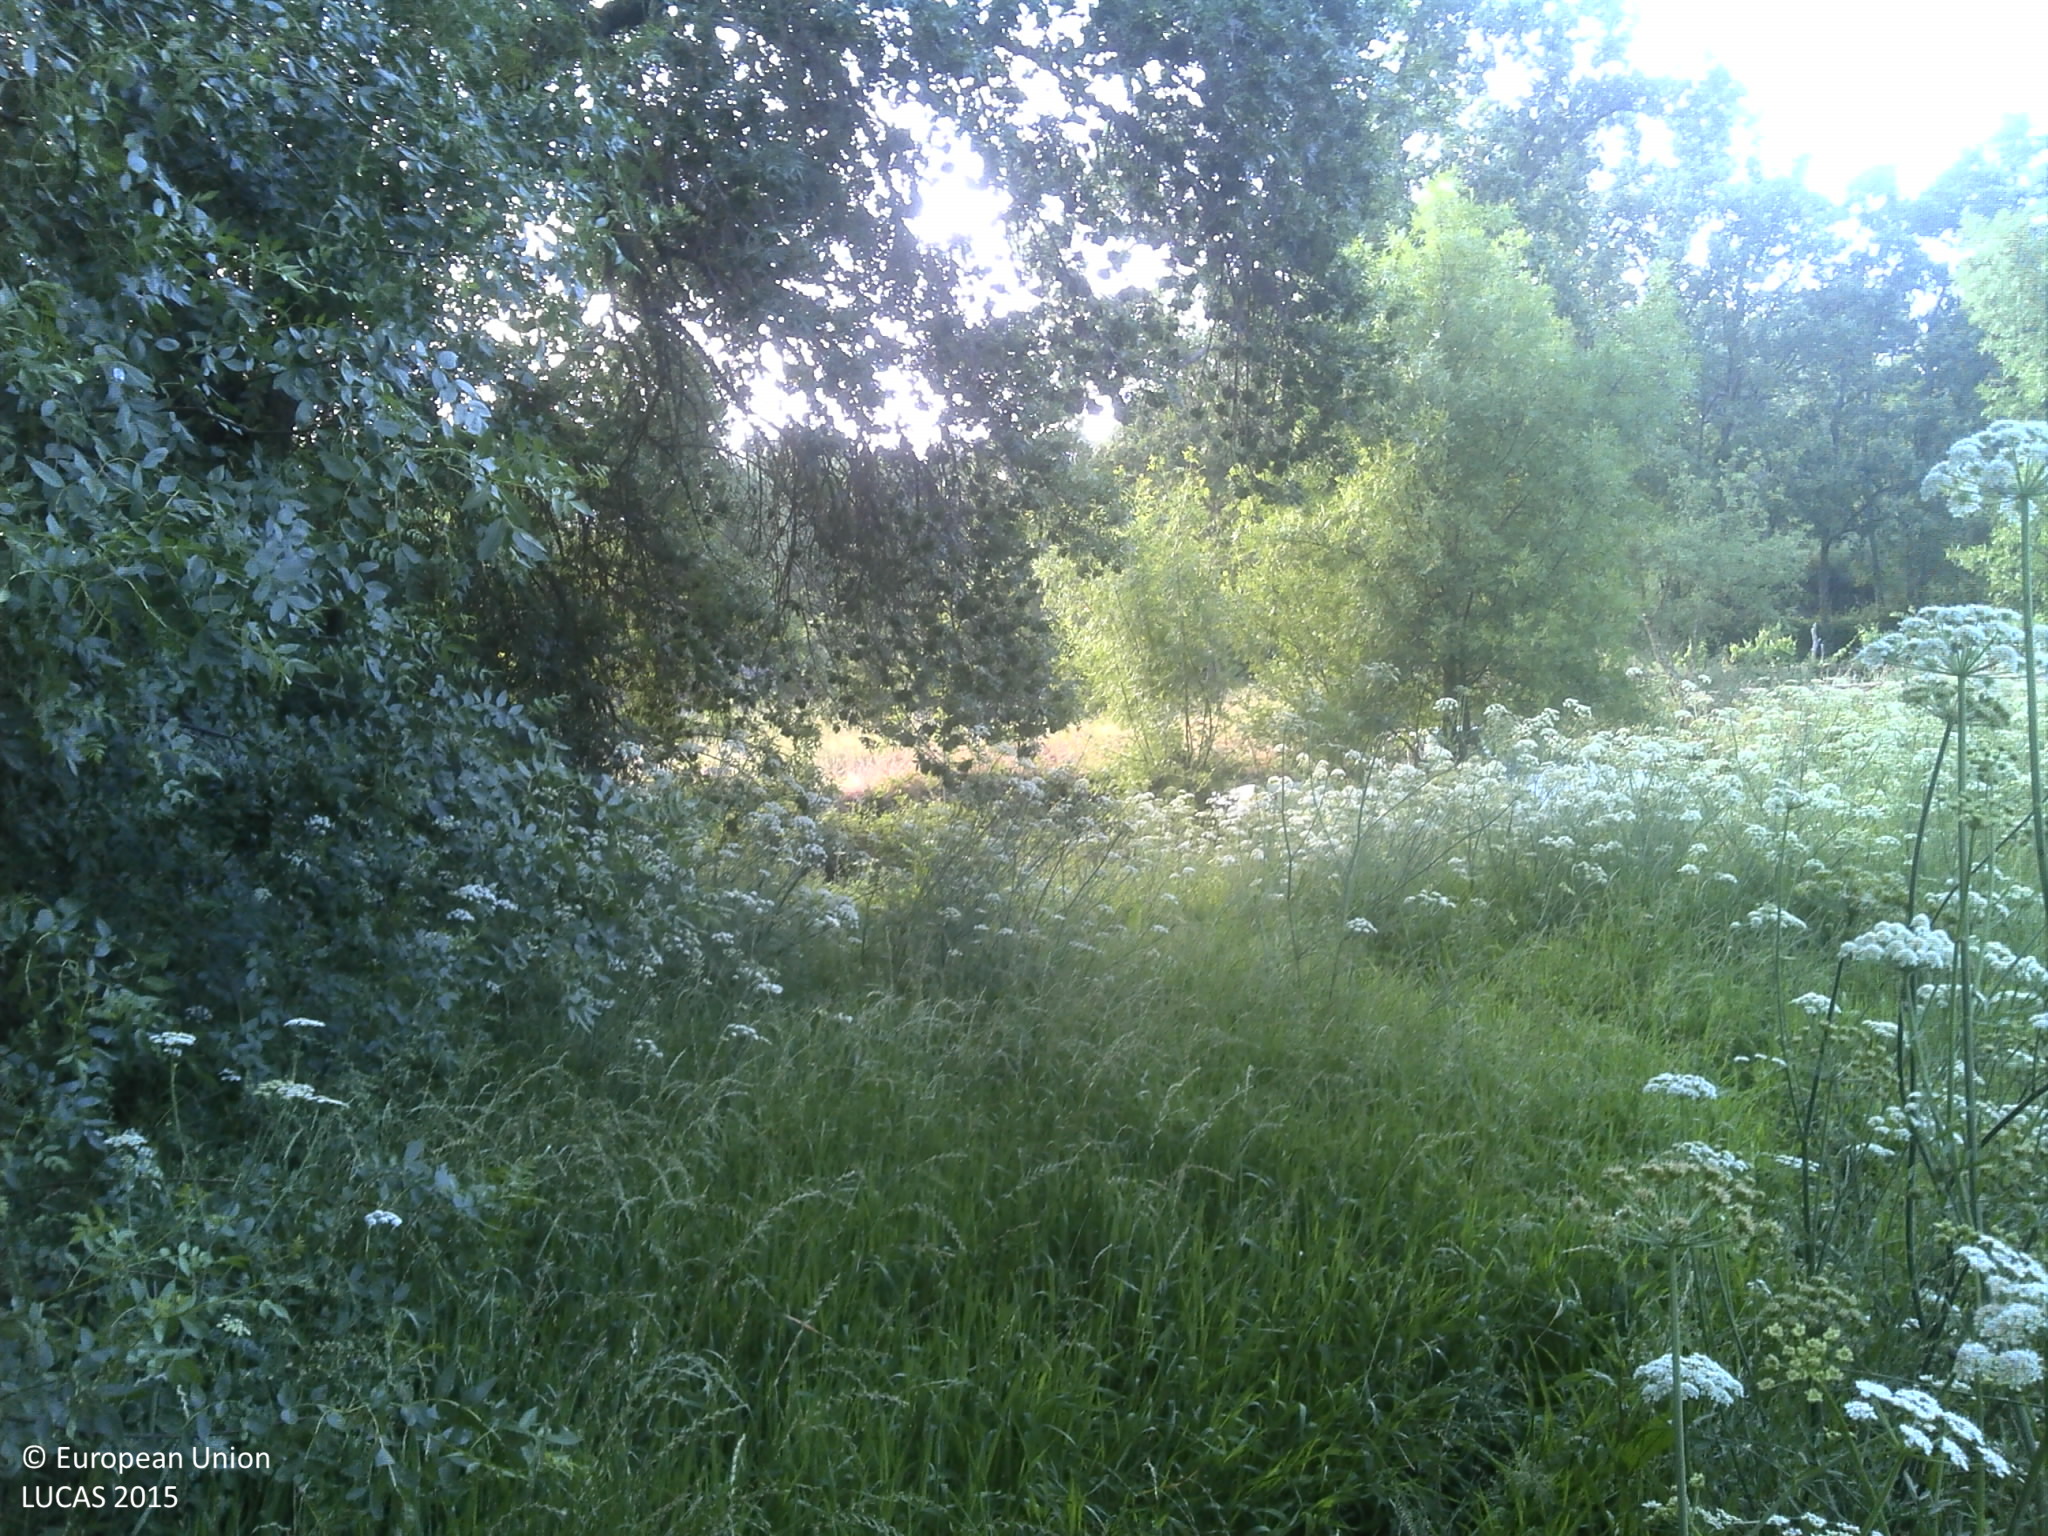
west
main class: Grassland
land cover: Spontaneously vegetated surfaces
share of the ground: 50 - 75 %
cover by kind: herbaceous plants 80 %, unconsolidated bare surface 20 %
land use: Fallow land
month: June
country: PT
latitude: 40.4650
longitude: -7.1193
